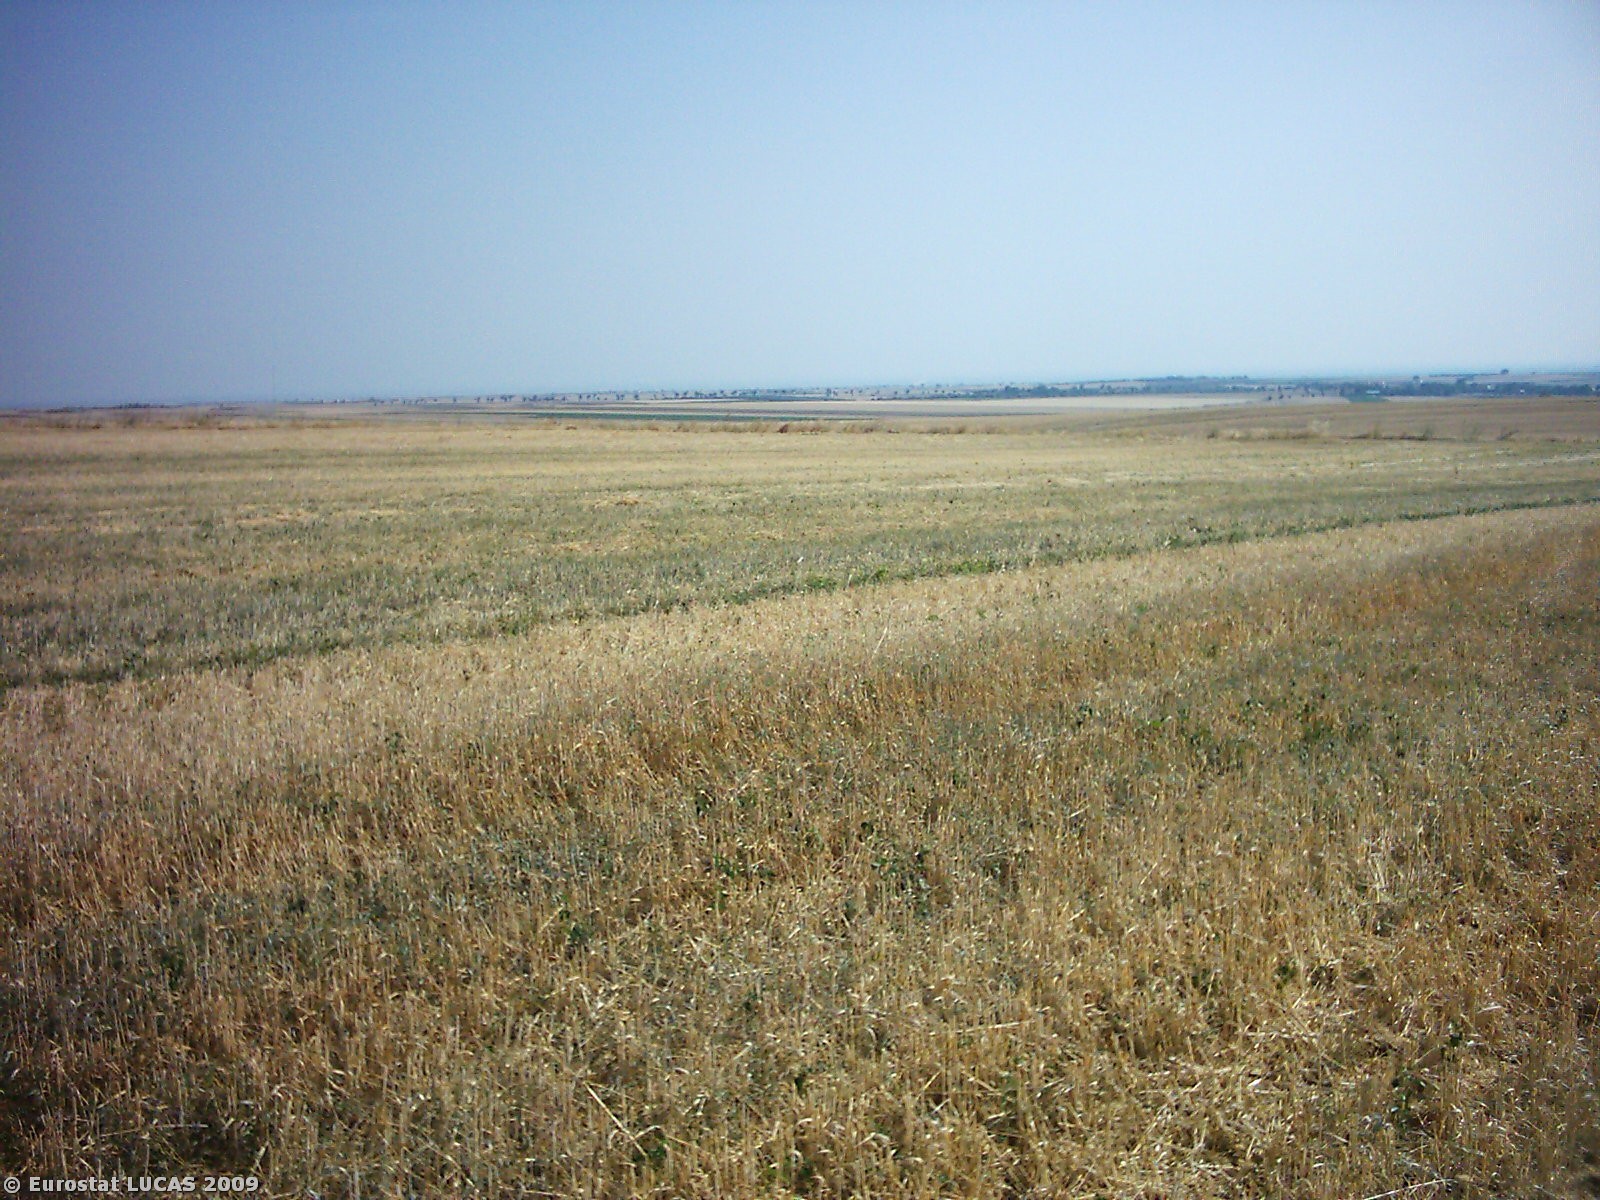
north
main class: Cropland
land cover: Durum wheat
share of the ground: < 10 %
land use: Agriculture (excluding fallow land and kitchen gardens)
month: July
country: IT
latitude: 41.1746
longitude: 15.6425
